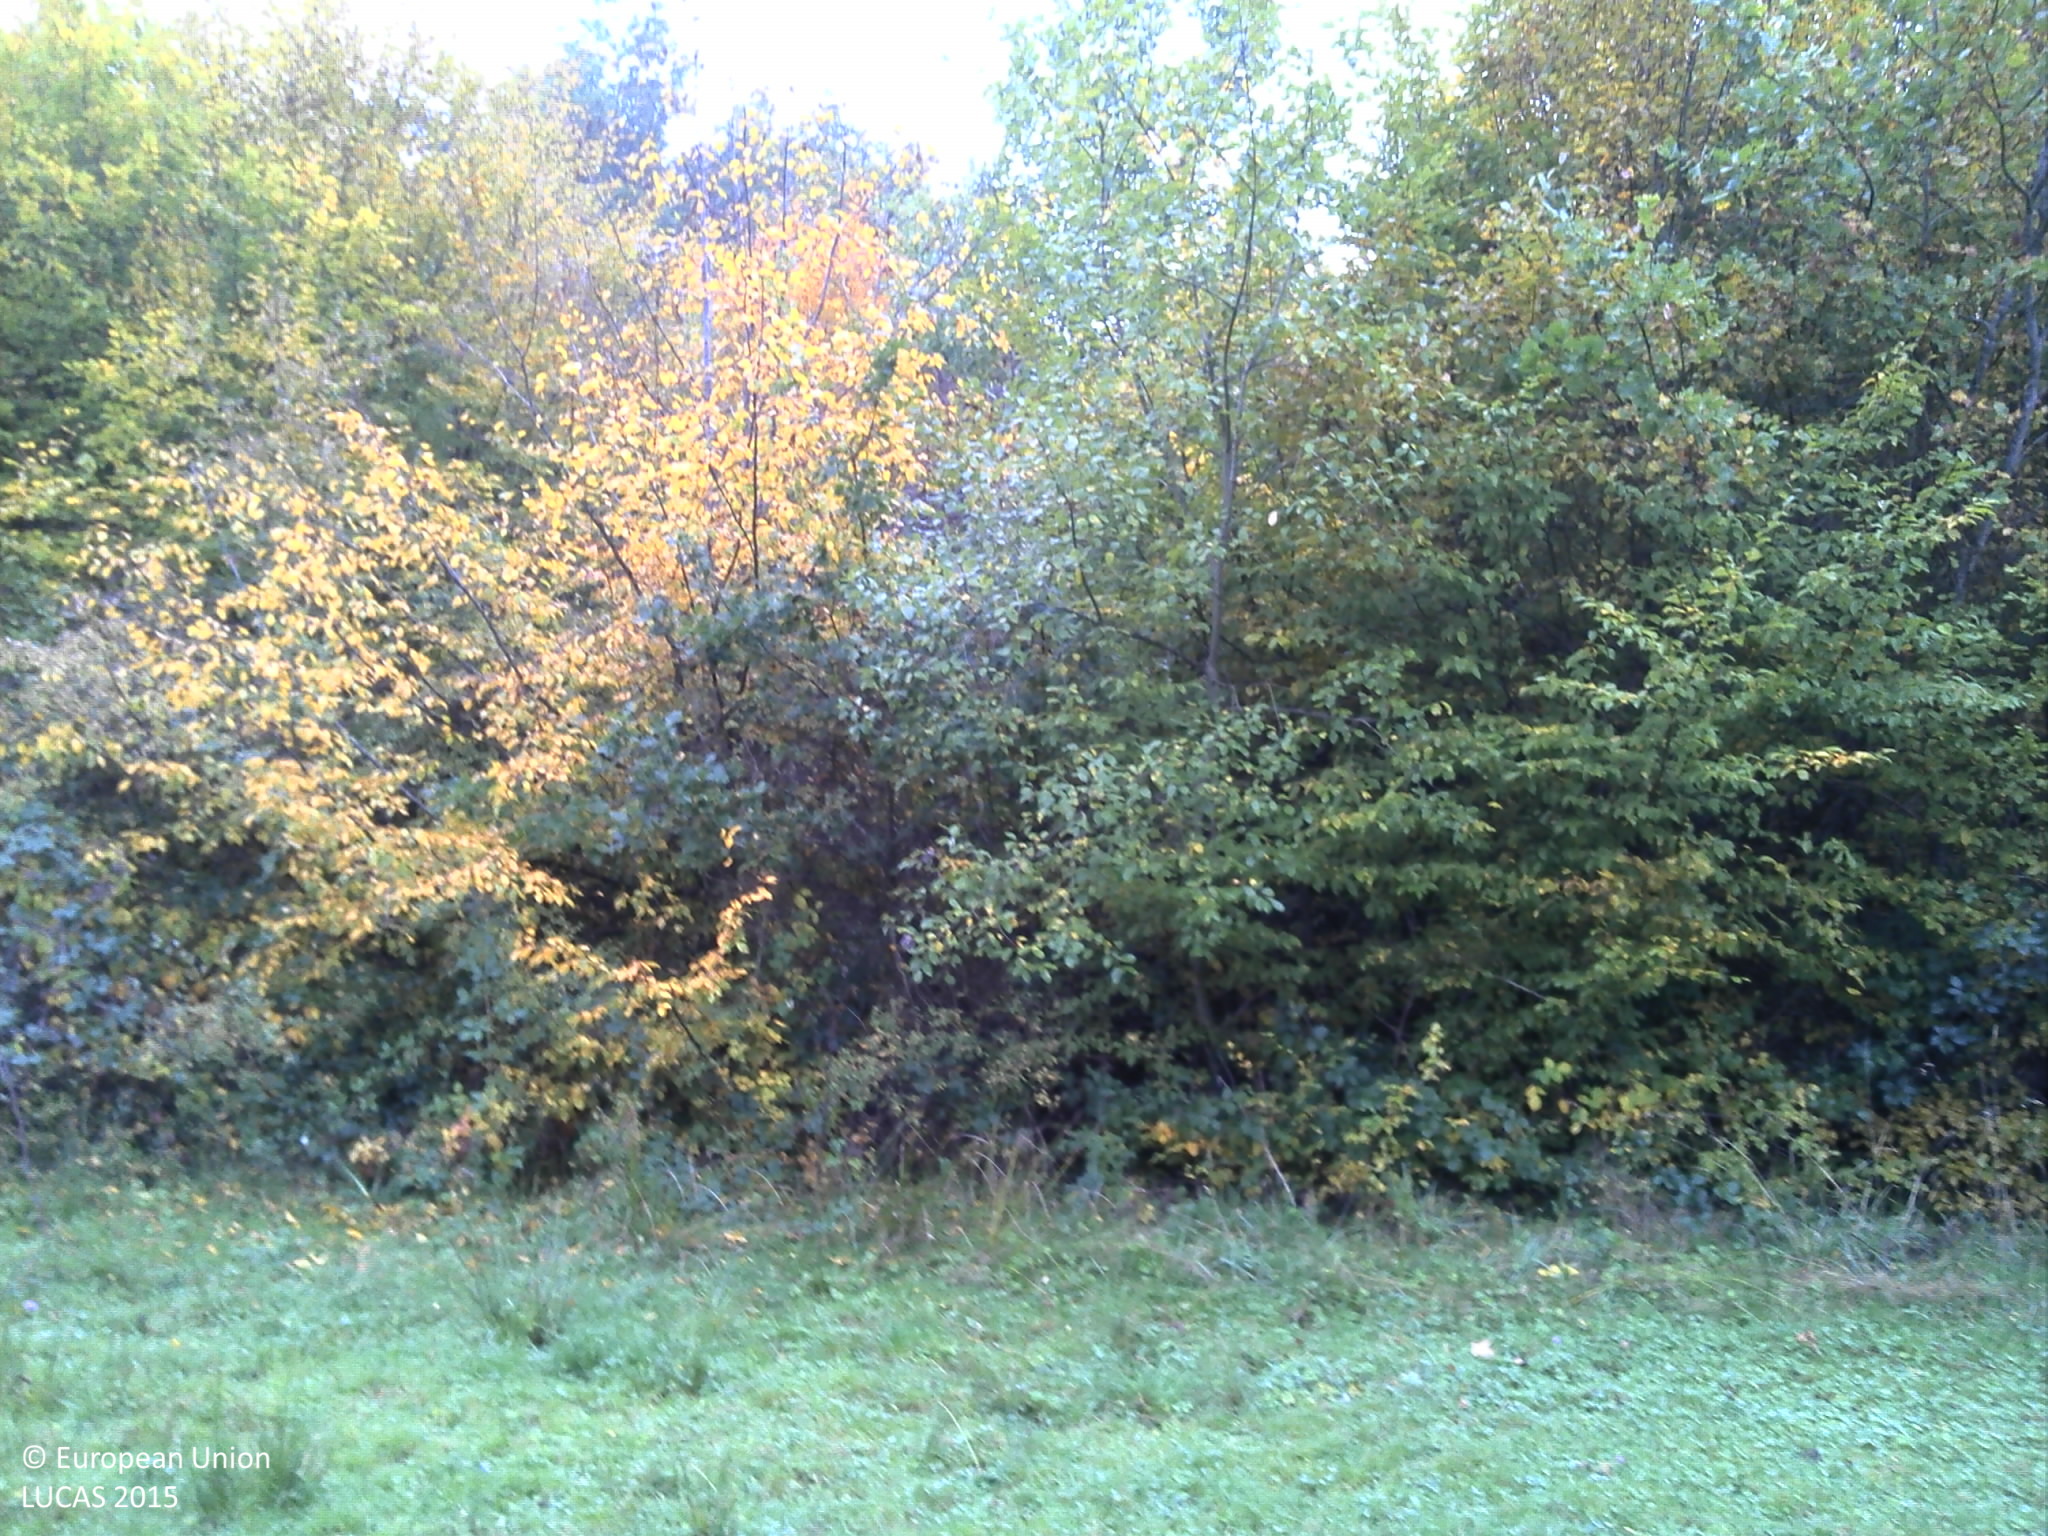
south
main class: Grassland
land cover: Grassland without tree/shrub cover
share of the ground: > 75 %
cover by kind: herbaceous plants 100 %
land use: Agriculture (excluding fallow land and kitchen gardens)
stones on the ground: < 10 %
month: October
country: FR
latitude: 45.6425
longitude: 3.4193
